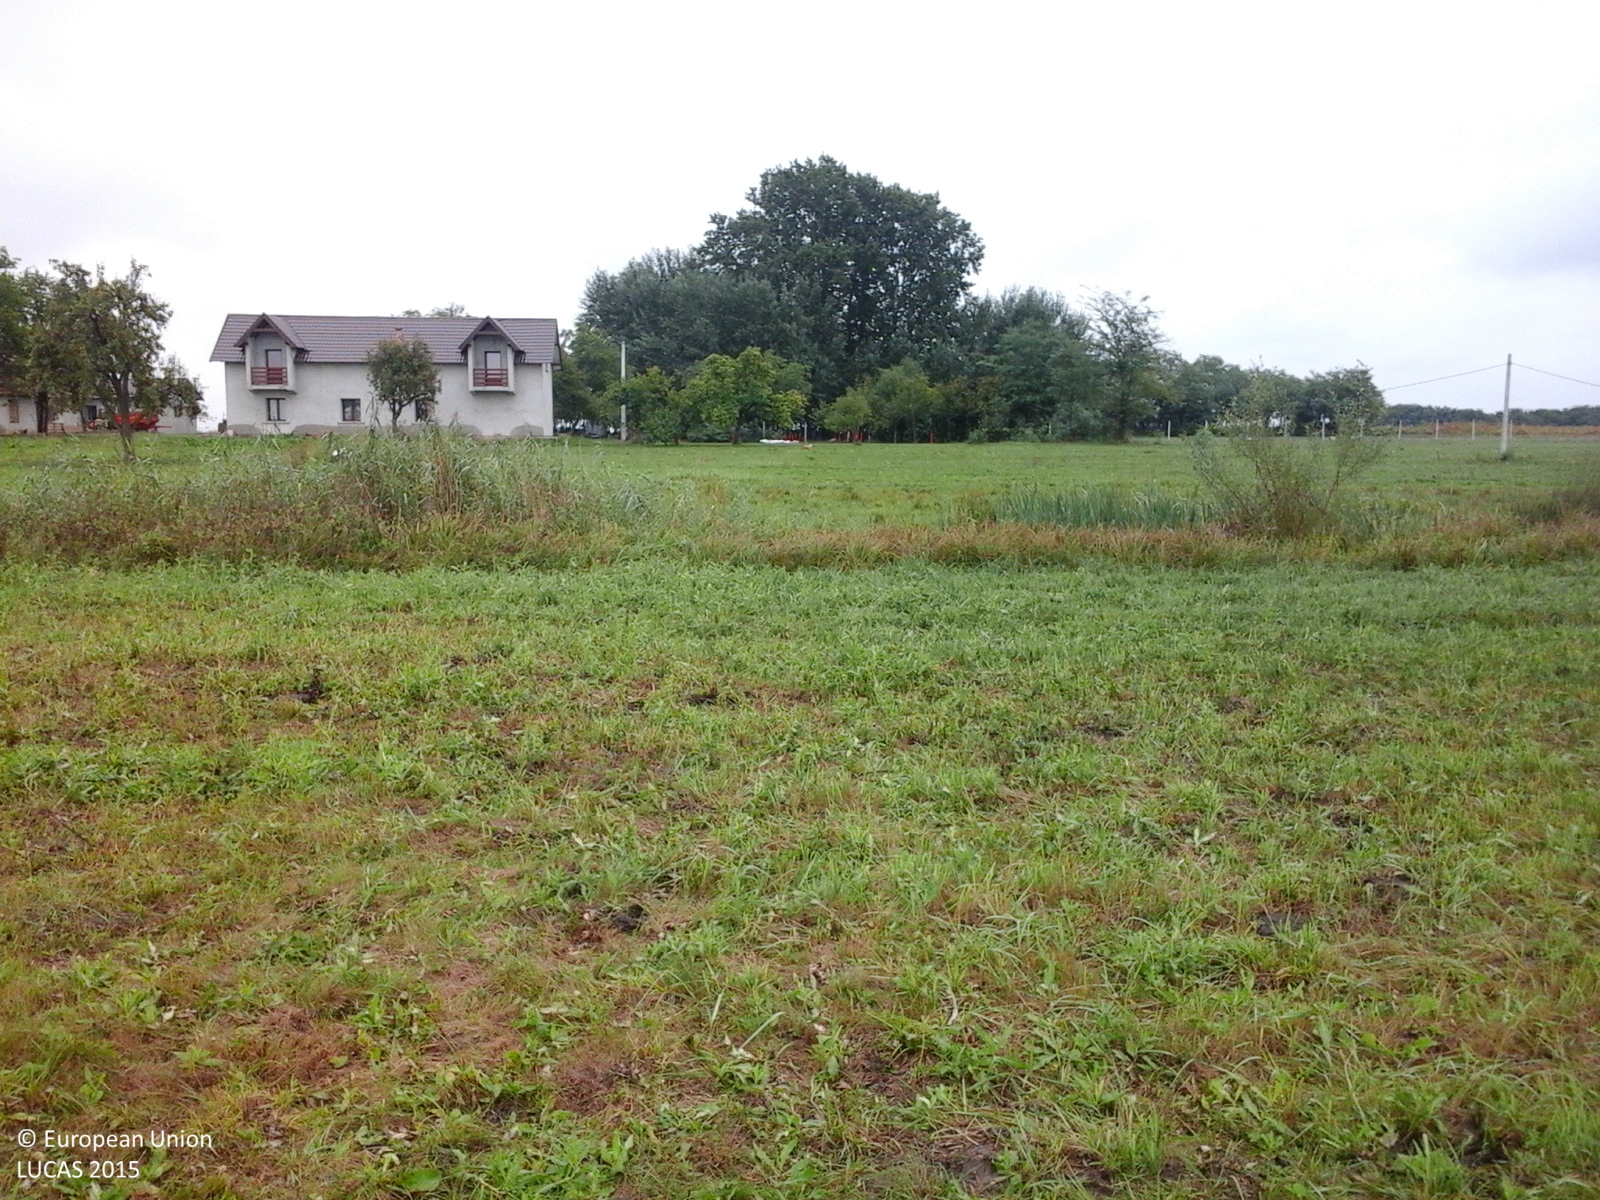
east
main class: Cropland
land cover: Maize
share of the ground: < 10 %
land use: Agriculture (excluding fallow land and kitchen gardens)
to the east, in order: Maize; Common wheat; Fences; Grassland without tree/shrub cover; Inland marshes; Inland fresh running water; Inland marshes; Spontaneously vegetated surfaces; Fences; Grassland without tree/shrub cover; Artificial constructions in urban areas; Apple fruit; Broadleaved woodland
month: September
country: RO
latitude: 46.8609
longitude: 21.6237
